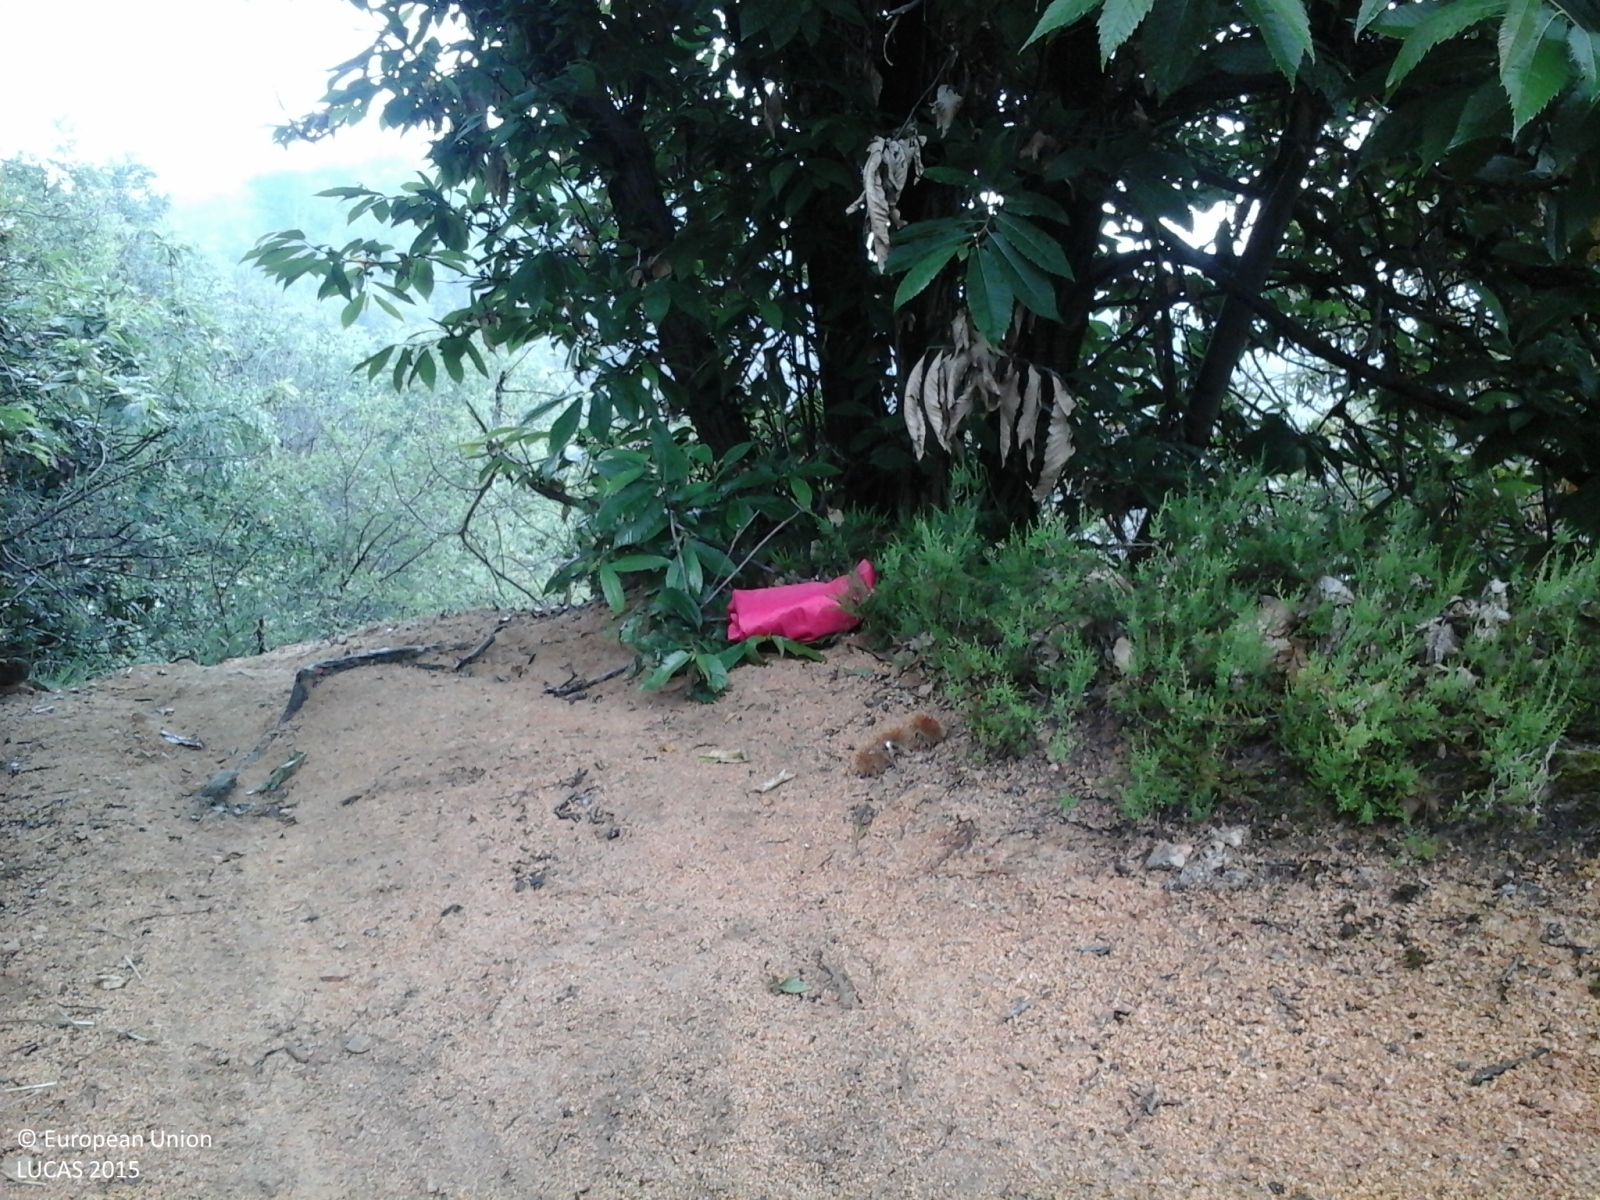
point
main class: Woodland
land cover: Broadleaved woodland
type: thermophilous deciduous forest
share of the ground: > 75 %
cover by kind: broadleaved forest trees 100 %
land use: Forestry
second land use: Amenities, museums, leisure
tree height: > 5 m
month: May
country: IT
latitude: 45.6336
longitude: 8.2197
